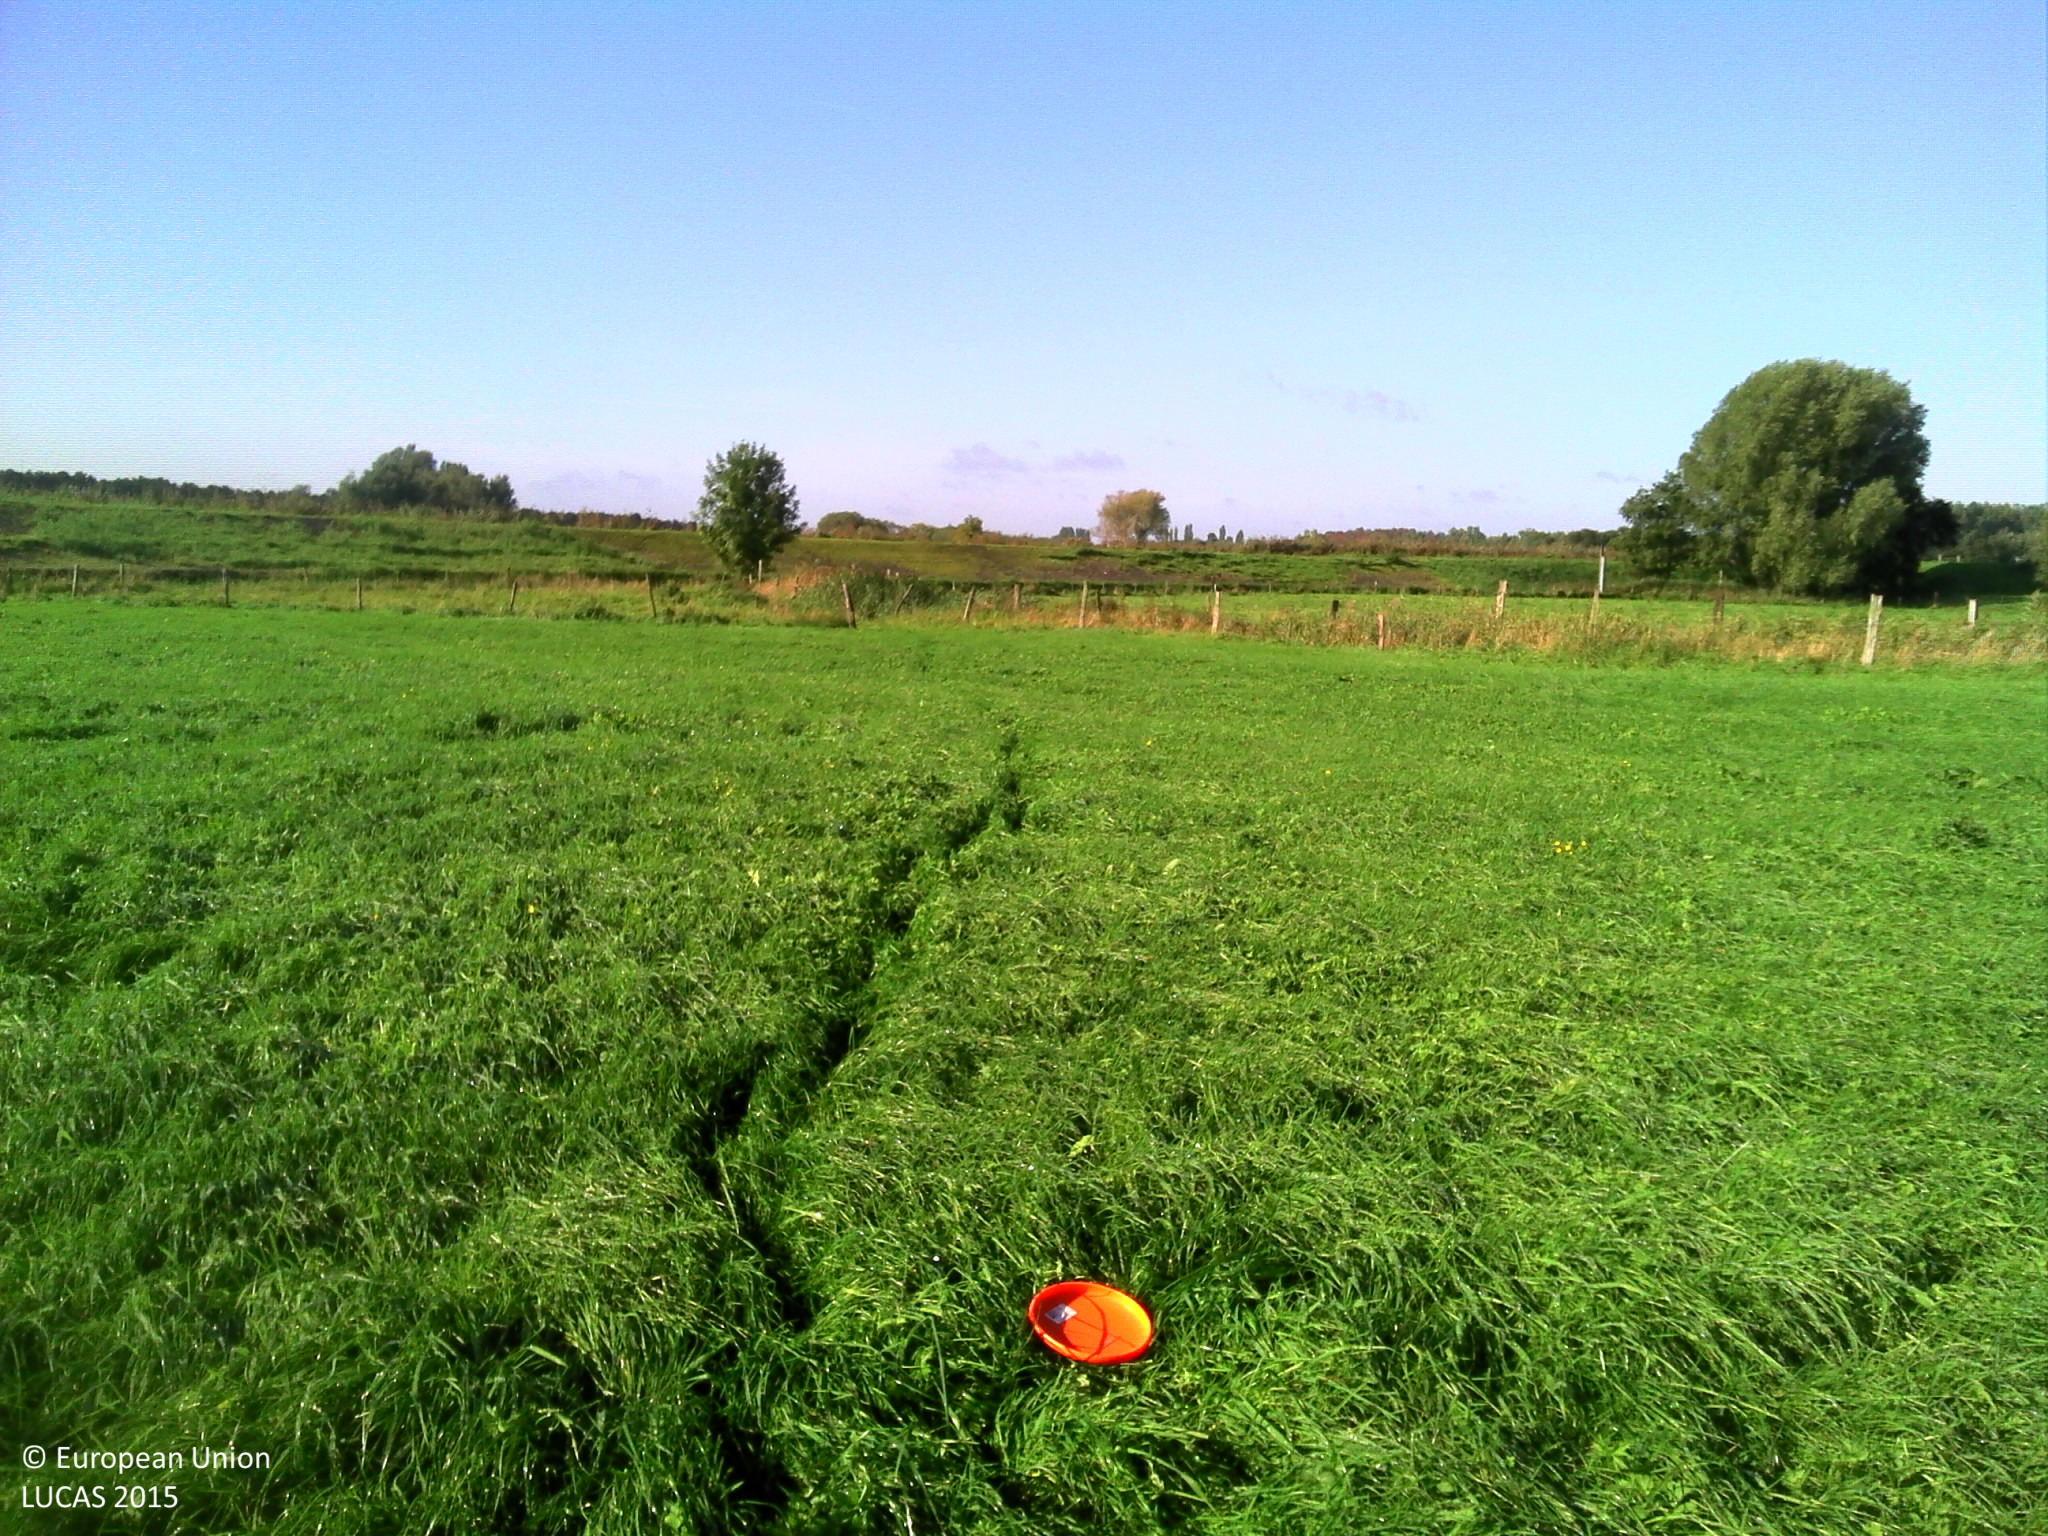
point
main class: Grassland
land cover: Grassland without tree/shrub cover
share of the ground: > 75 %
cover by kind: herbaceous plants 100 %
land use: Agriculture (excluding fallow land and kitchen gardens)
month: September
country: BE
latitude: 51.1174
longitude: 4.5530
